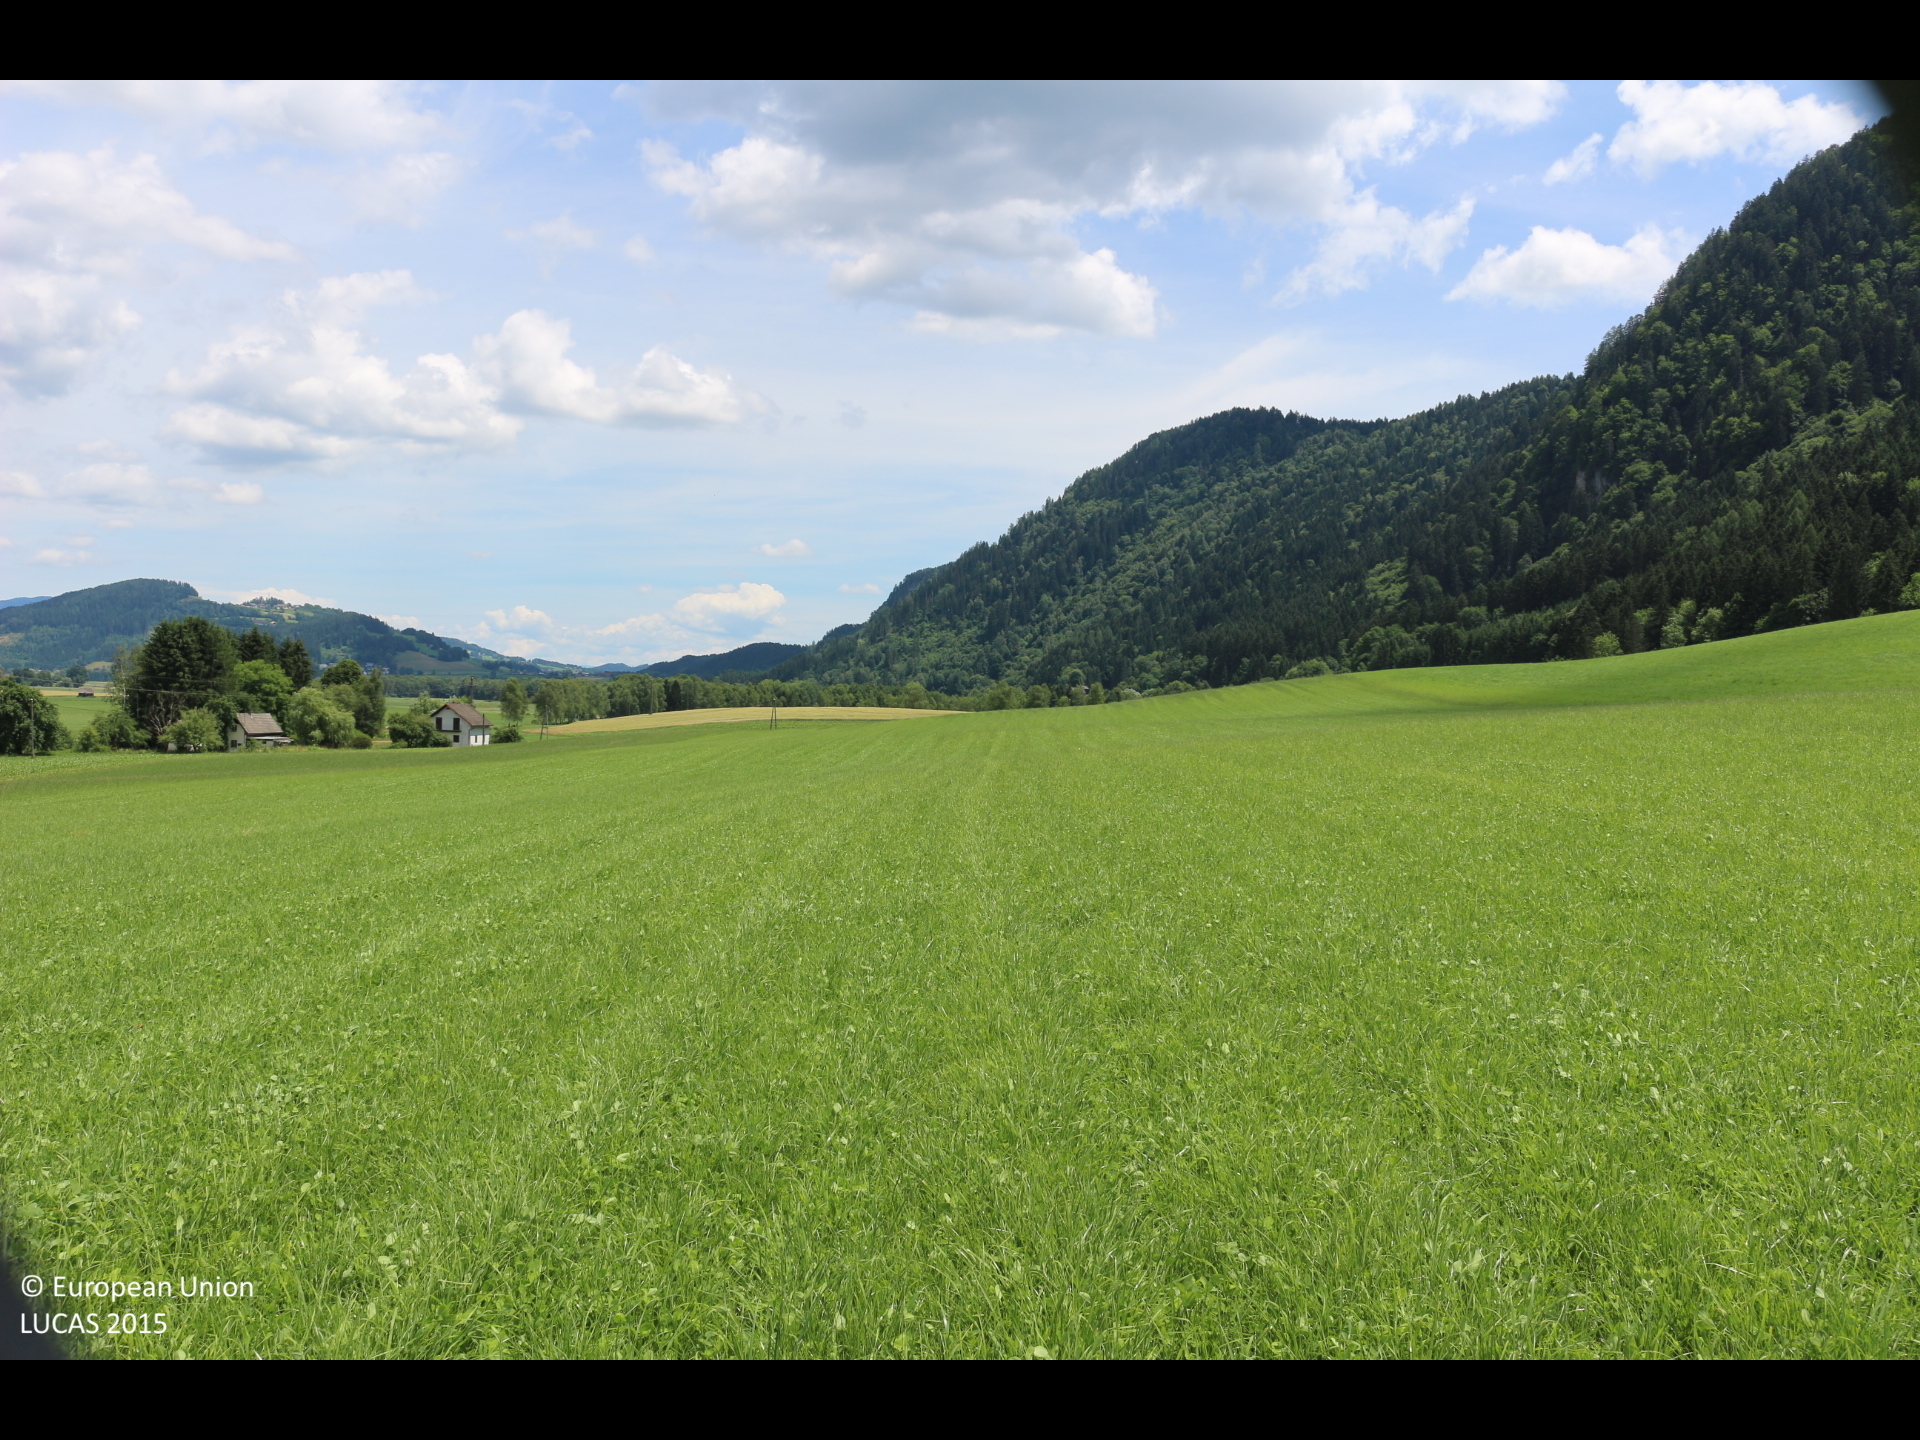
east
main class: Cropland
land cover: Temporary grasslands
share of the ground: > 75 %
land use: Agriculture (excluding fallow land and kitchen gardens)
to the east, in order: Temporary grasslands
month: June
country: AT
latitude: 46.6897
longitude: 14.0378
